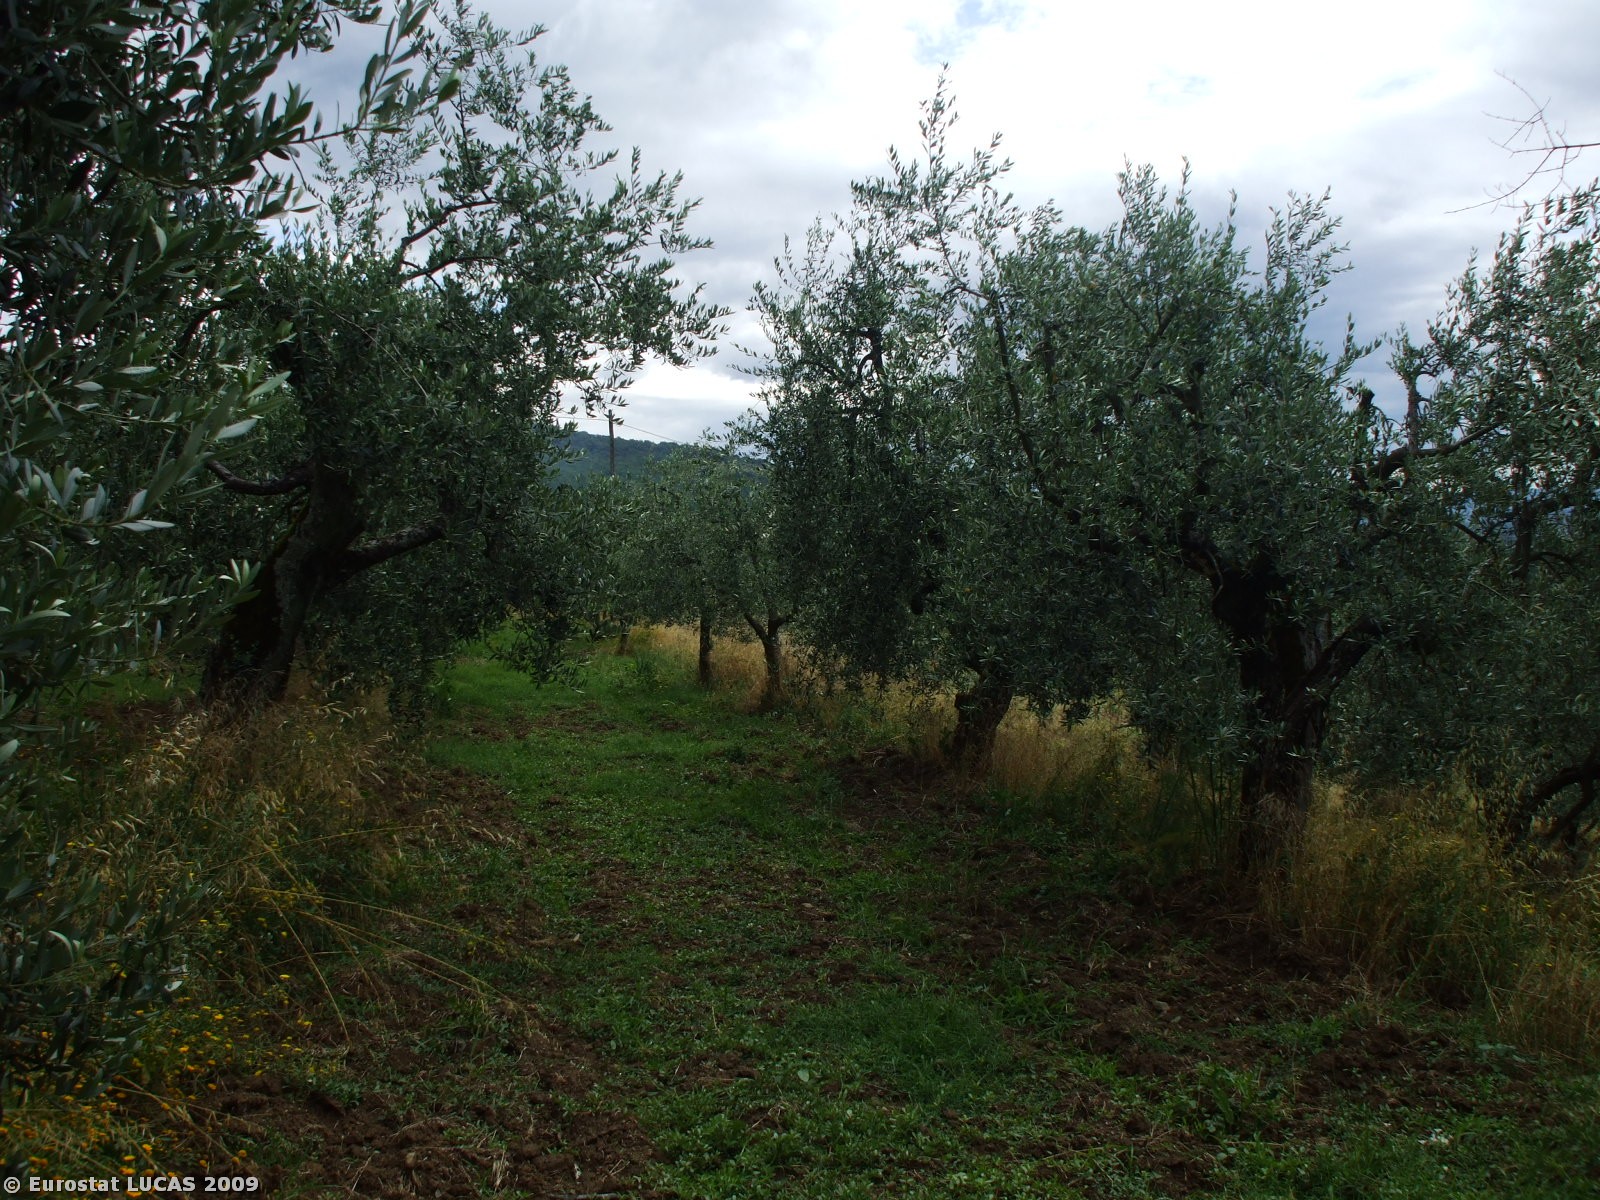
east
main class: Cropland
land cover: Olive groves
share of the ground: 10 - 25 %
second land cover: Spontaneously vegetated surfaces
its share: > 75 %
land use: Agriculture (excluding fallow land and kitchen gardens)
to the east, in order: Olive groves; Spontaneously vegetated surfaces; Electric lines; Olive groves; Spontaneously vegetated surfaces; Other fresh vegetables; Artificial constructions in urban areas; Olive groves; Spontaneously vegetated surfaces; Electric lines; Olive groves; Grassland with sparse tree/shrub cover
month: June
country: IT
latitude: 43.5612
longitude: 11.6668
